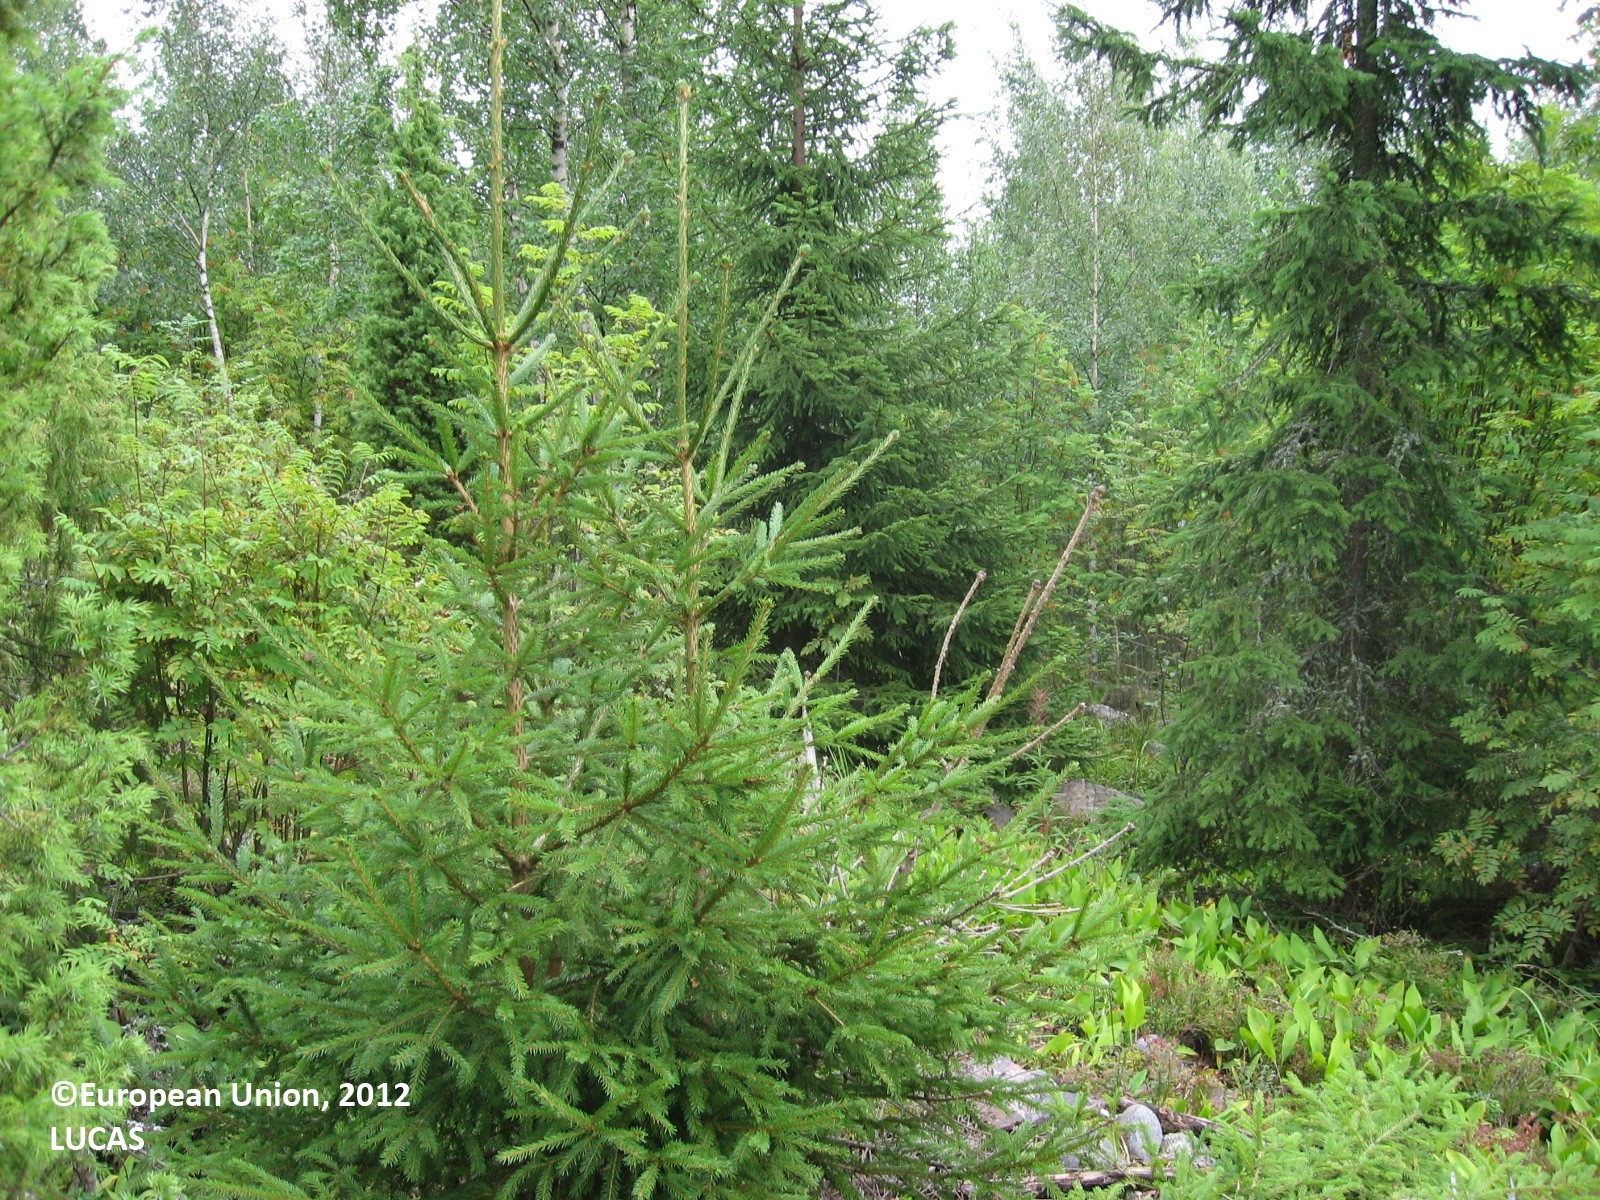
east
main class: Woodland
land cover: Spruce dominated mixed woodland
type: boreal forest
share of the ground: 50 - 75 %
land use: Forestry
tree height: < 5 m
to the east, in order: Spruce dominated mixed woodland; Electric lines; Dry stone walls; Spruce dominated mixed woodland; Tracks; Spruce dominated mixed woodland; Dry pulses; Grass margins; Ditches and canals; Grass margins; Common wheat
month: August
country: FI
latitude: 60.5706
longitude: 25.4723
